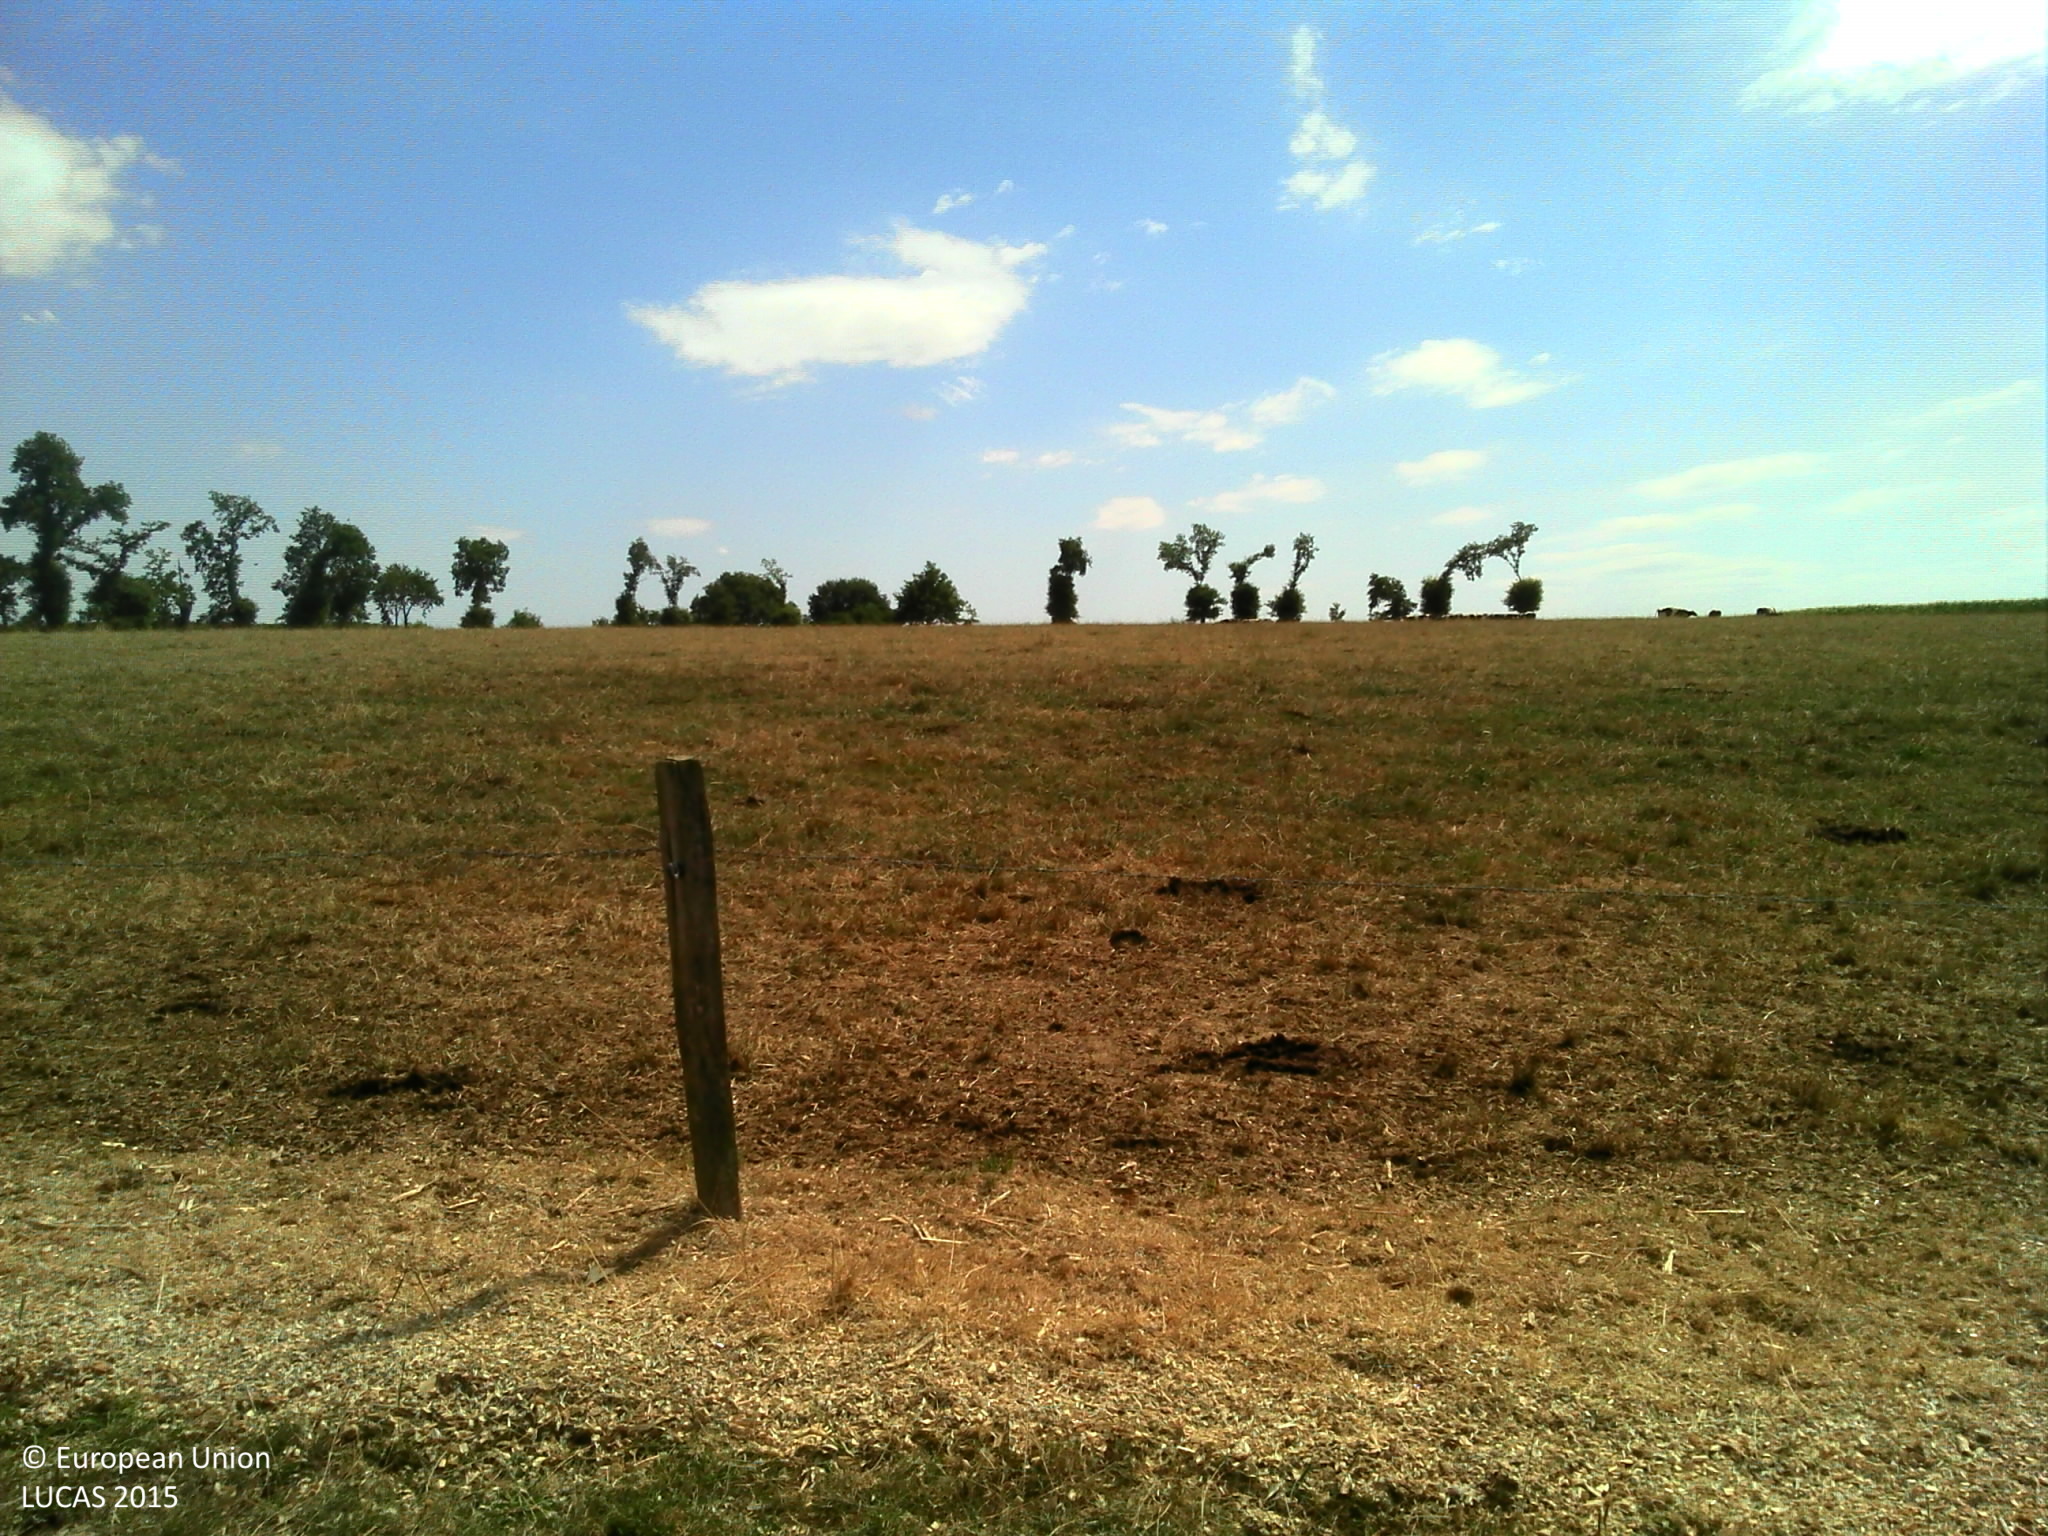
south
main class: Grassland
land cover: Grassland without tree/shrub cover
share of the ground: > 75 %
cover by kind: herbaceous plants 100 %
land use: Agriculture (excluding fallow land and kitchen gardens)
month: August
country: FR
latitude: 47.8916
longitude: -1.1546
